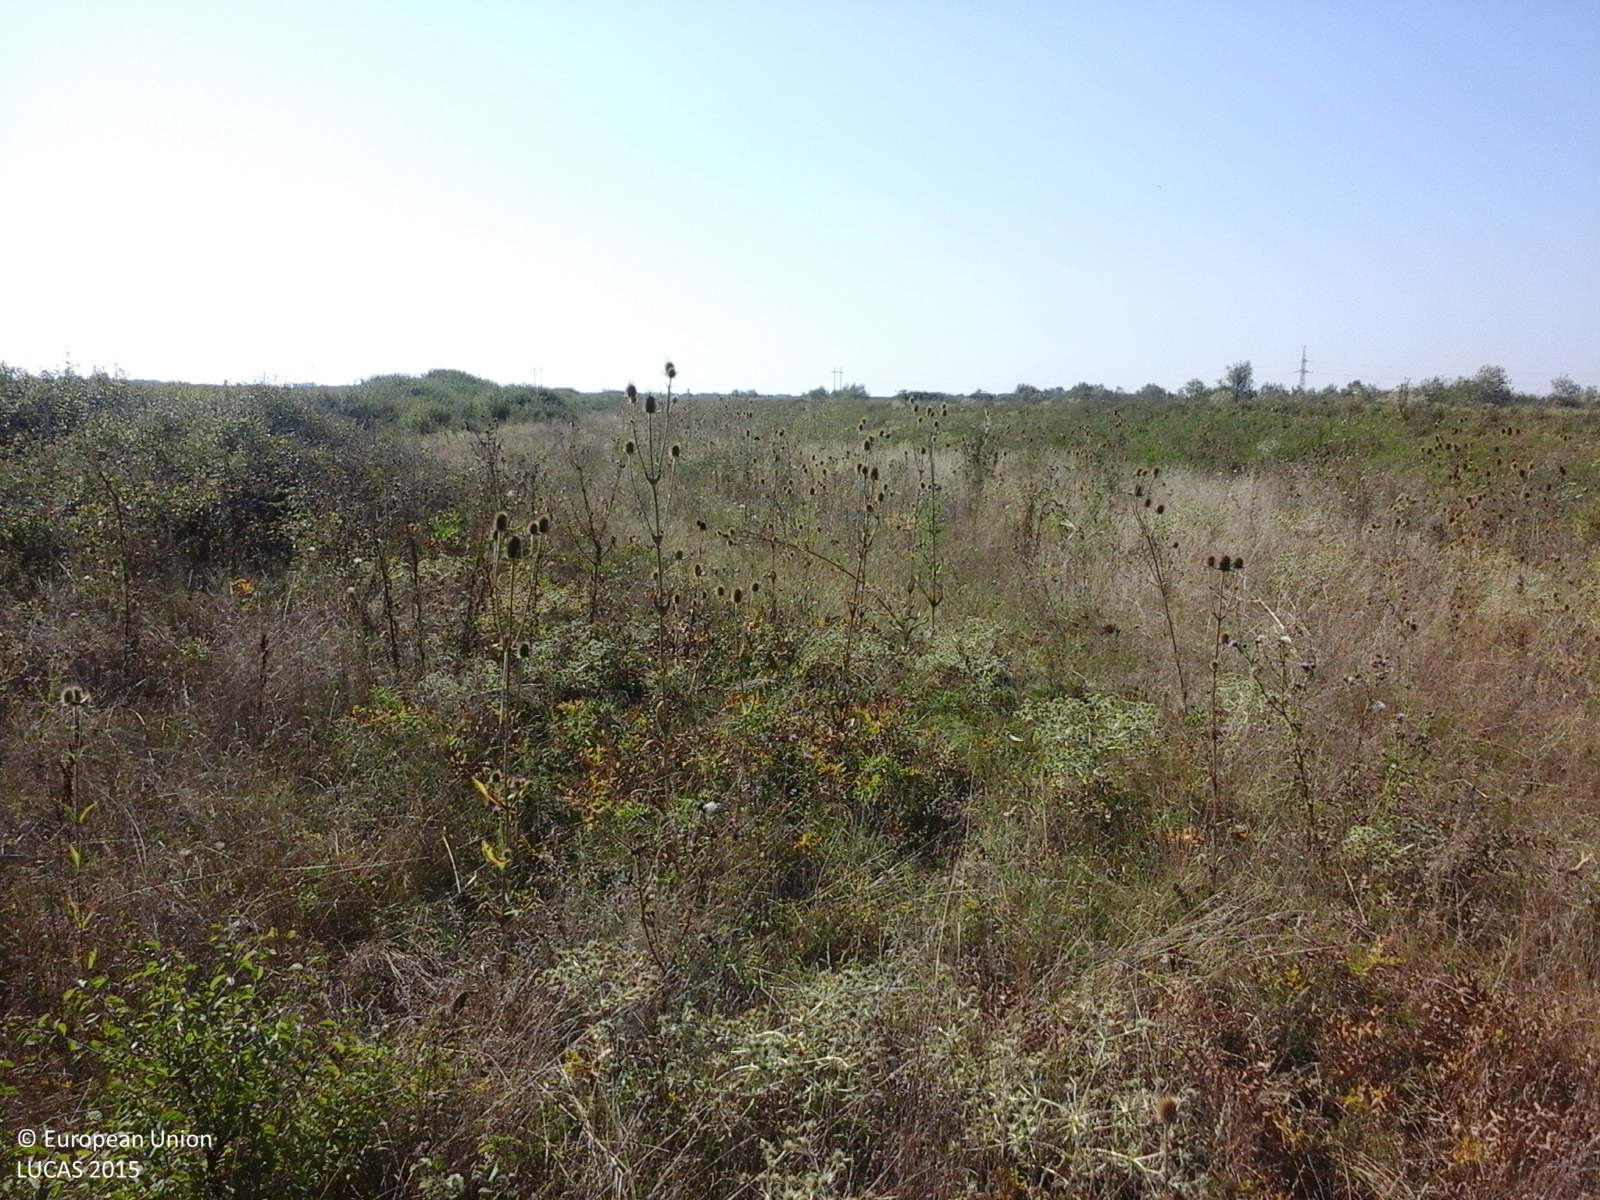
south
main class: Shrubland
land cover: Shrubland without tree cover
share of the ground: > 75 %
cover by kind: shrubs 95 %, herbaceous plants 5 %
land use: Semi-natural and natural areas not in use
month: August
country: RO
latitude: 45.6705
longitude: 21.3663
